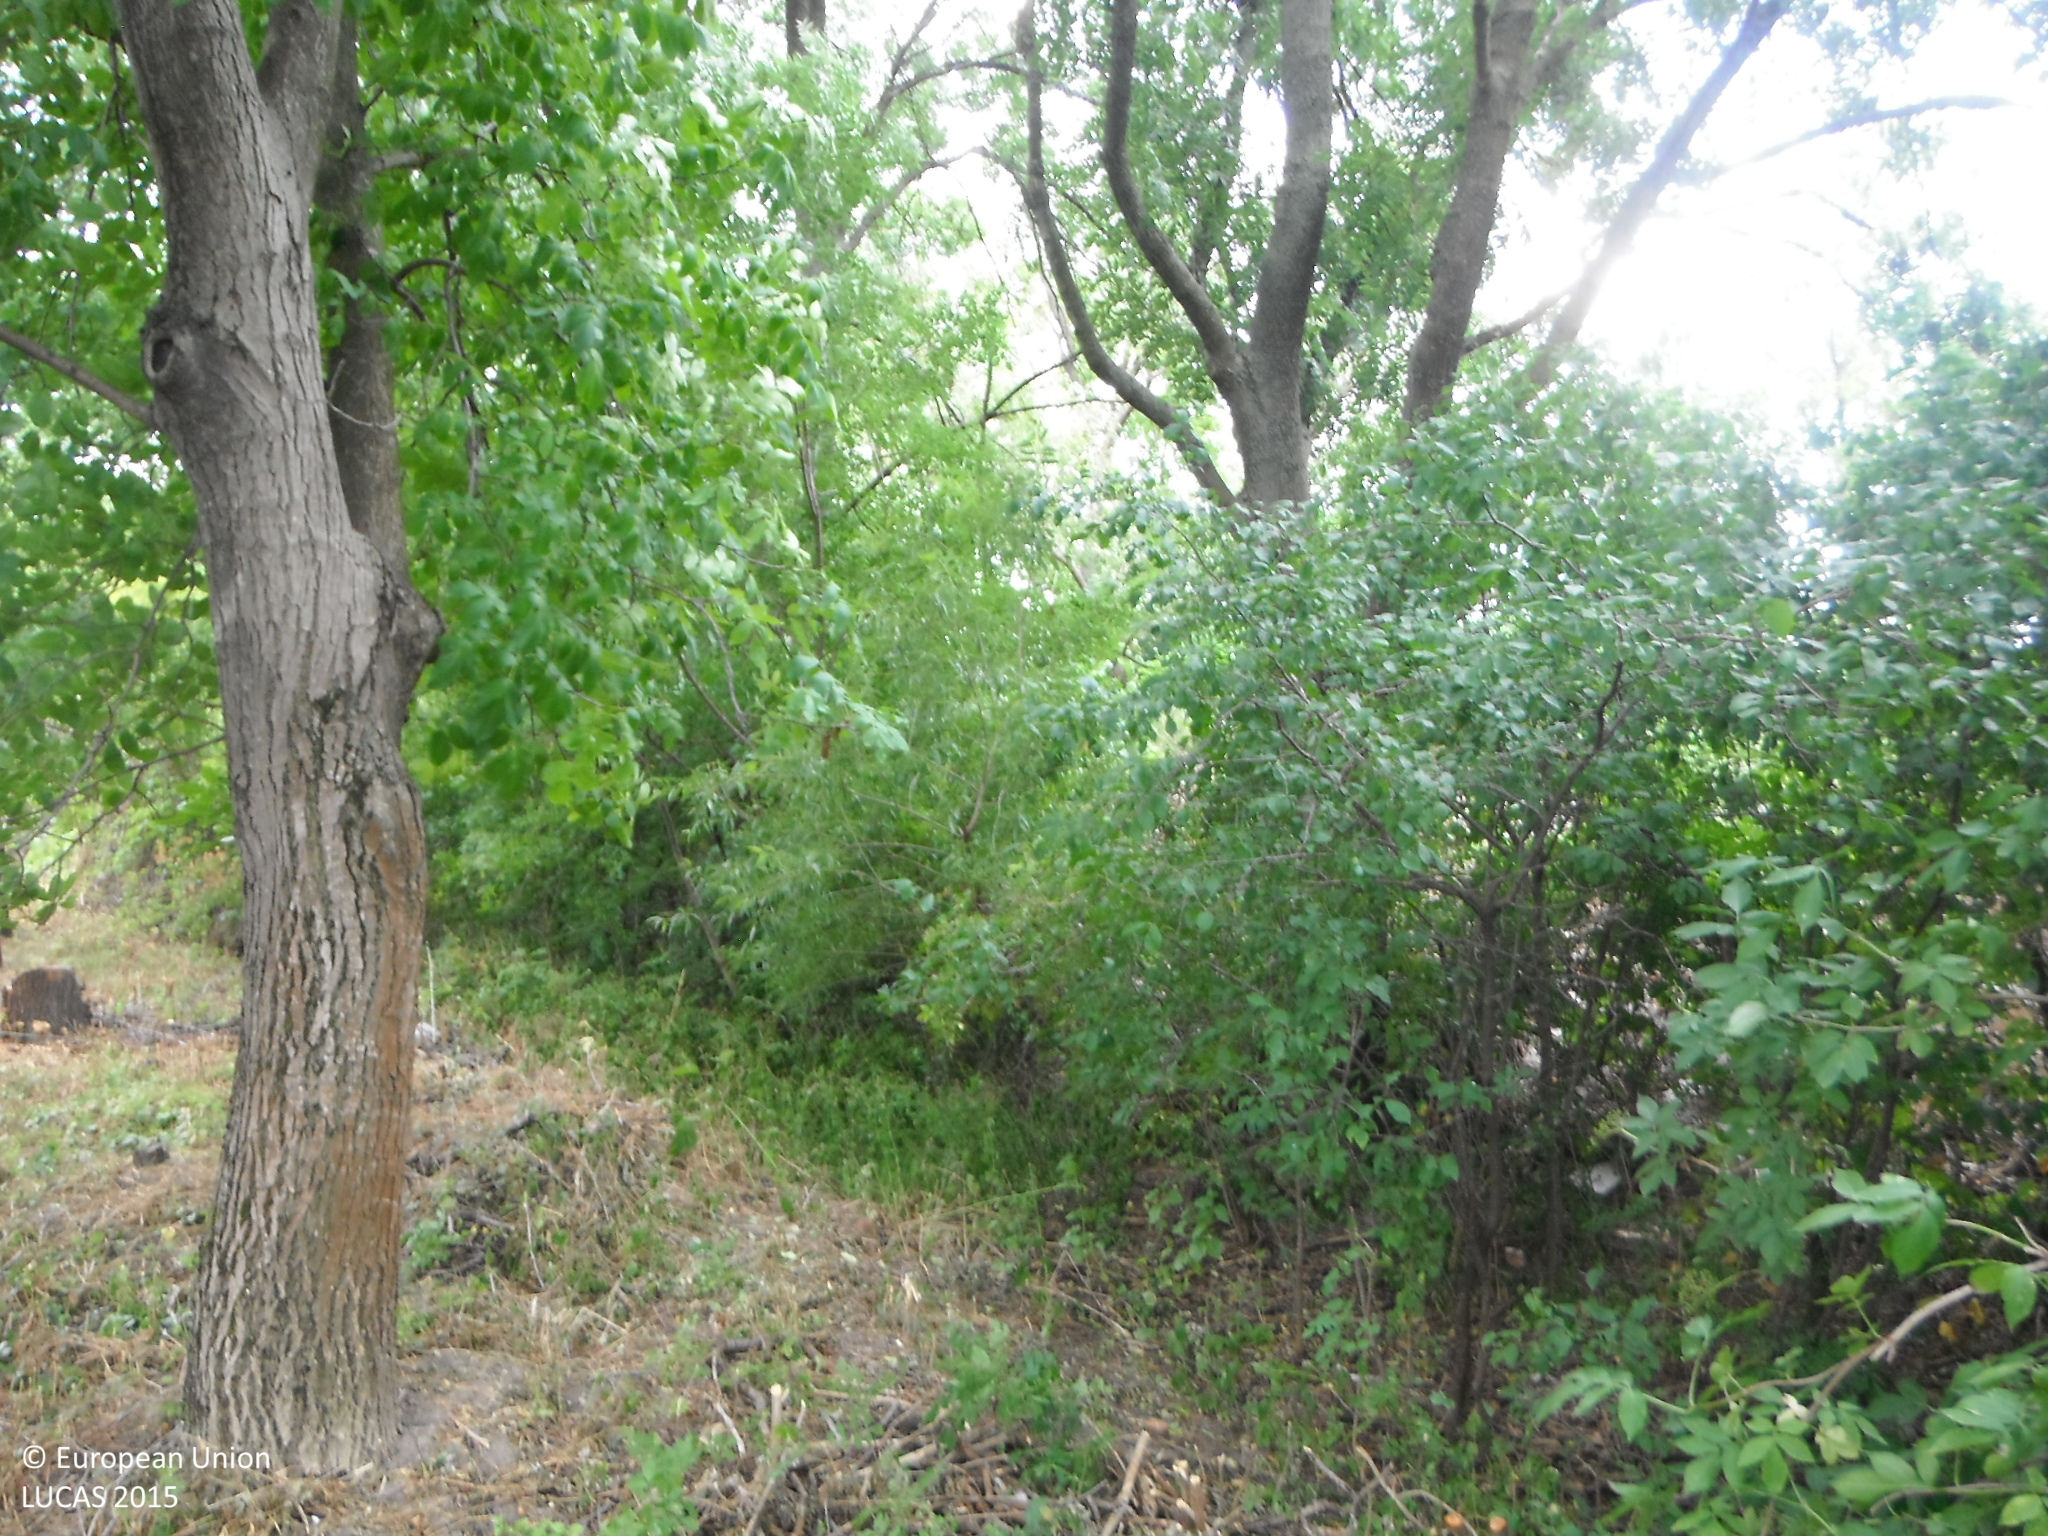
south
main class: Cropland
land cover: Other fruit trees and berries
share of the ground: 10 - 25 %
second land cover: Grassland without tree/shrub cover
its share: > 75 %
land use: Kitchen garden
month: July
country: SK
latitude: 48.4844
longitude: 18.1184
